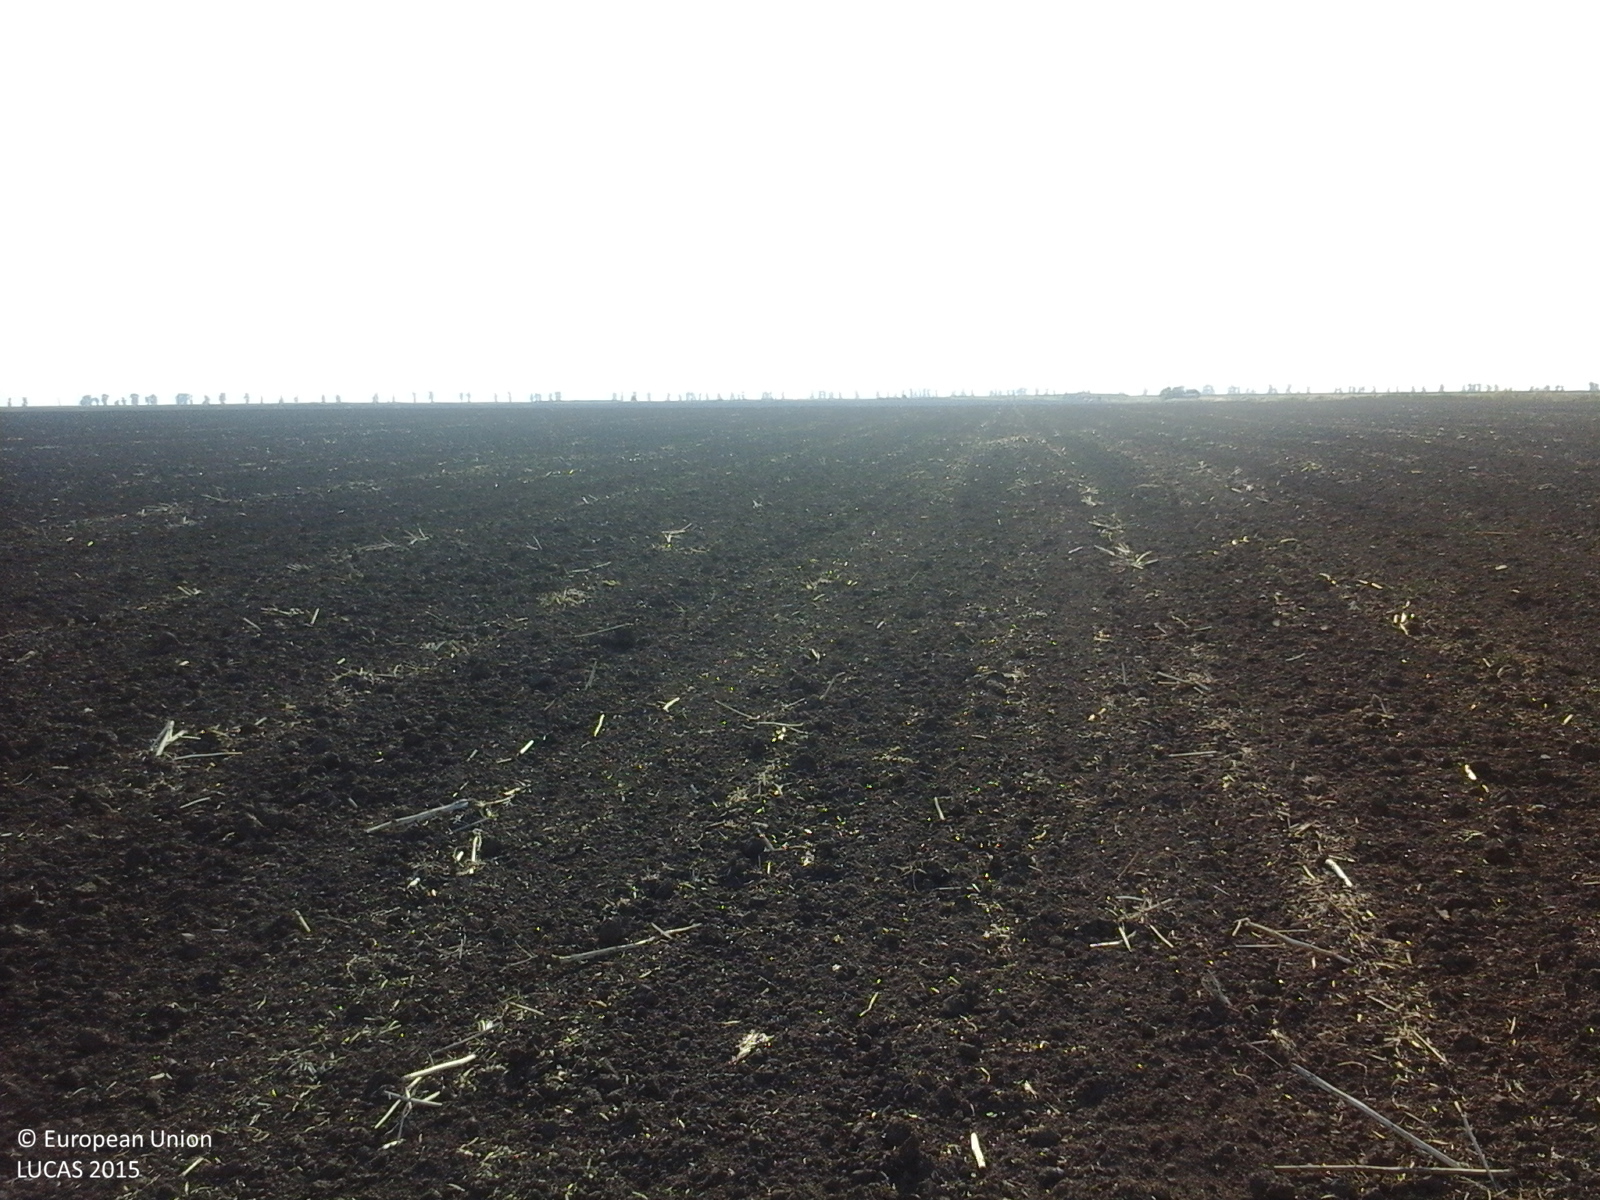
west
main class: Cropland
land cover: Common wheat
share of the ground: < 10 %
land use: Agriculture (excluding fallow land and kitchen gardens)
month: July
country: RO
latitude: 44.6997
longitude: 27.3418
